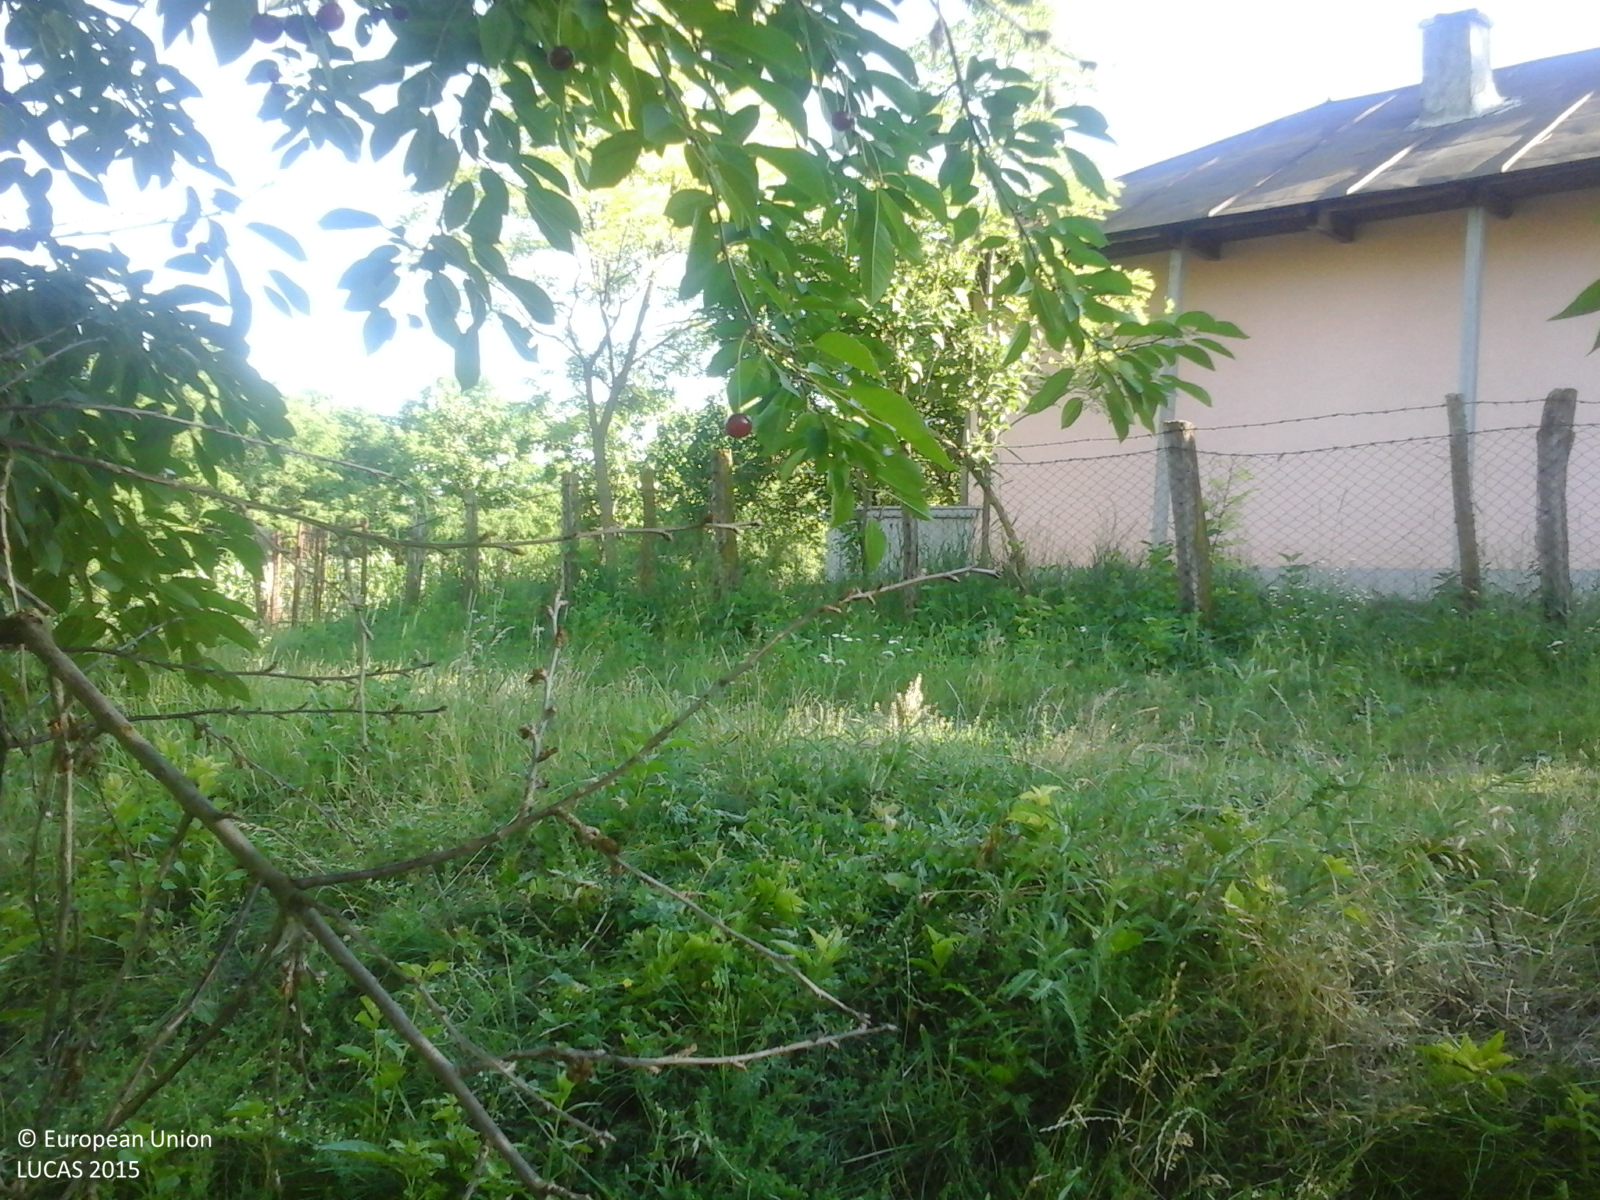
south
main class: Woodland
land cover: Broadleaved woodland
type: broadleaved evergreen forest
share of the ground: > 75 %
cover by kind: broadleaved forest trees 100 %
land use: Forestry
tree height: > 5 m
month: June
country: RO
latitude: 47.7551
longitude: 27.2266
